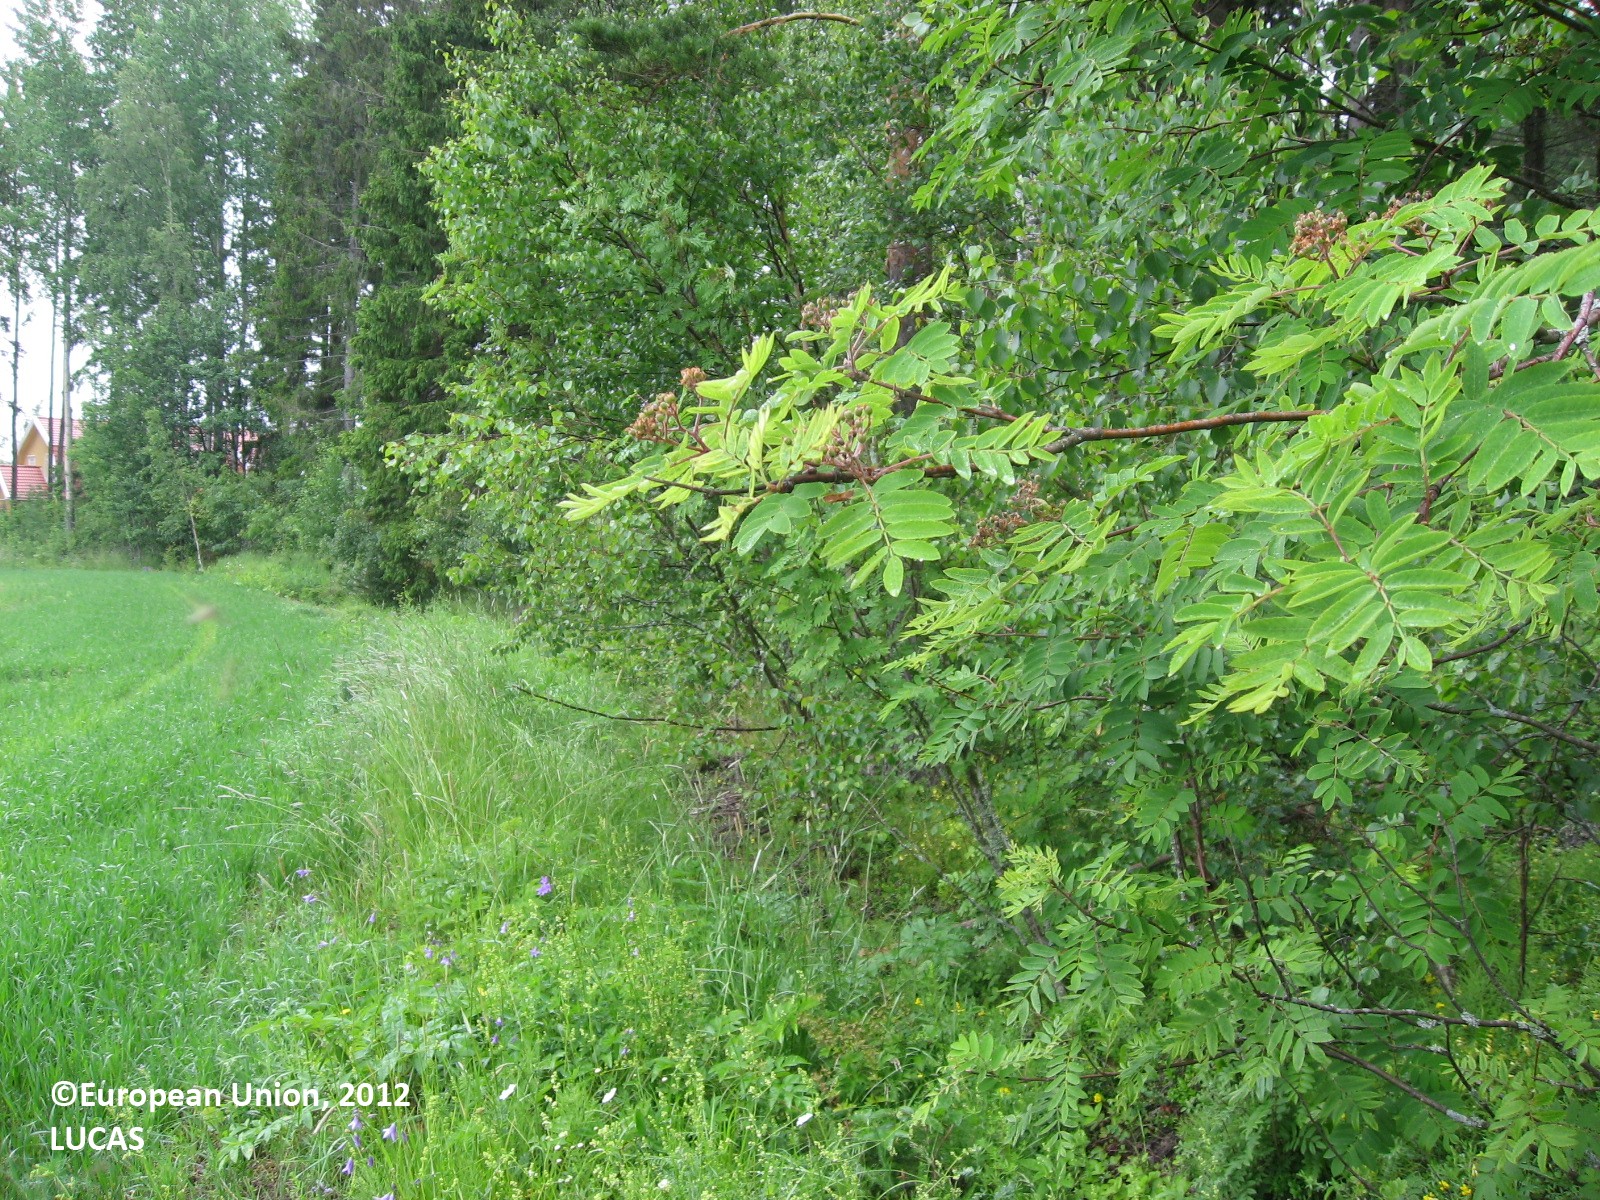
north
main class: Cropland
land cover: Common wheat
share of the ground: > 75 %
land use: Agriculture (excluding fallow land and kitchen gardens)
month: June
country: FI
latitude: 60.5337
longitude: 26.1282
